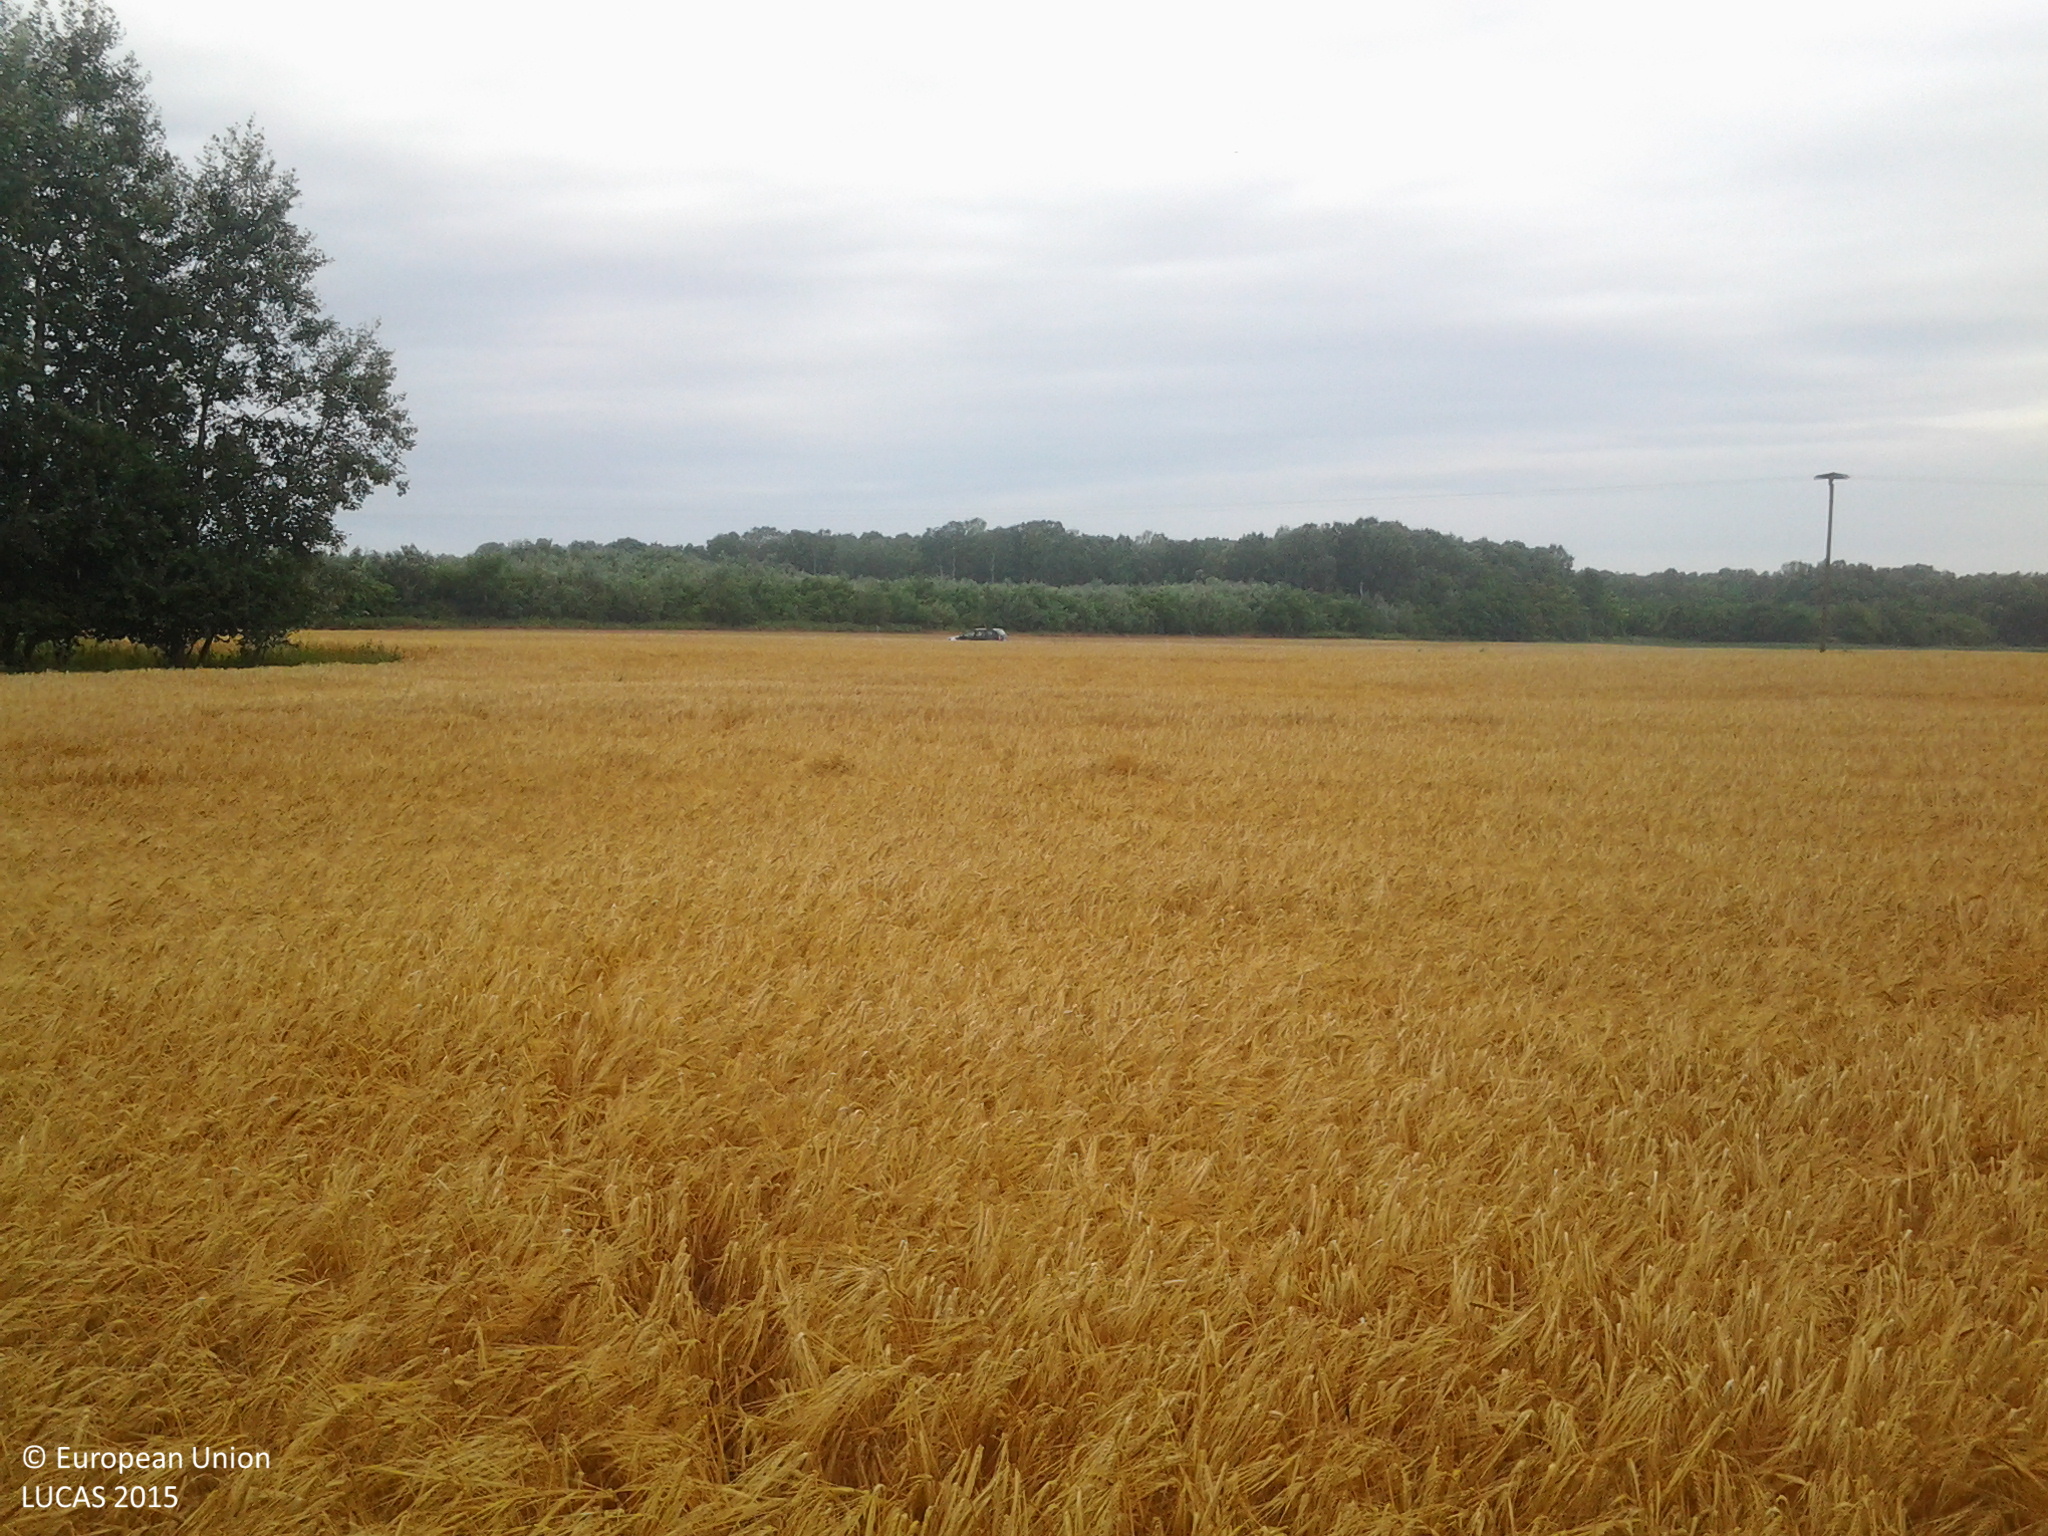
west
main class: Cropland
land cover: Barley
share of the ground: > 75 %
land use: Agriculture (excluding fallow land and kitchen gardens)
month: July
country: HU
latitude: 46.9437
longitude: 19.0675
